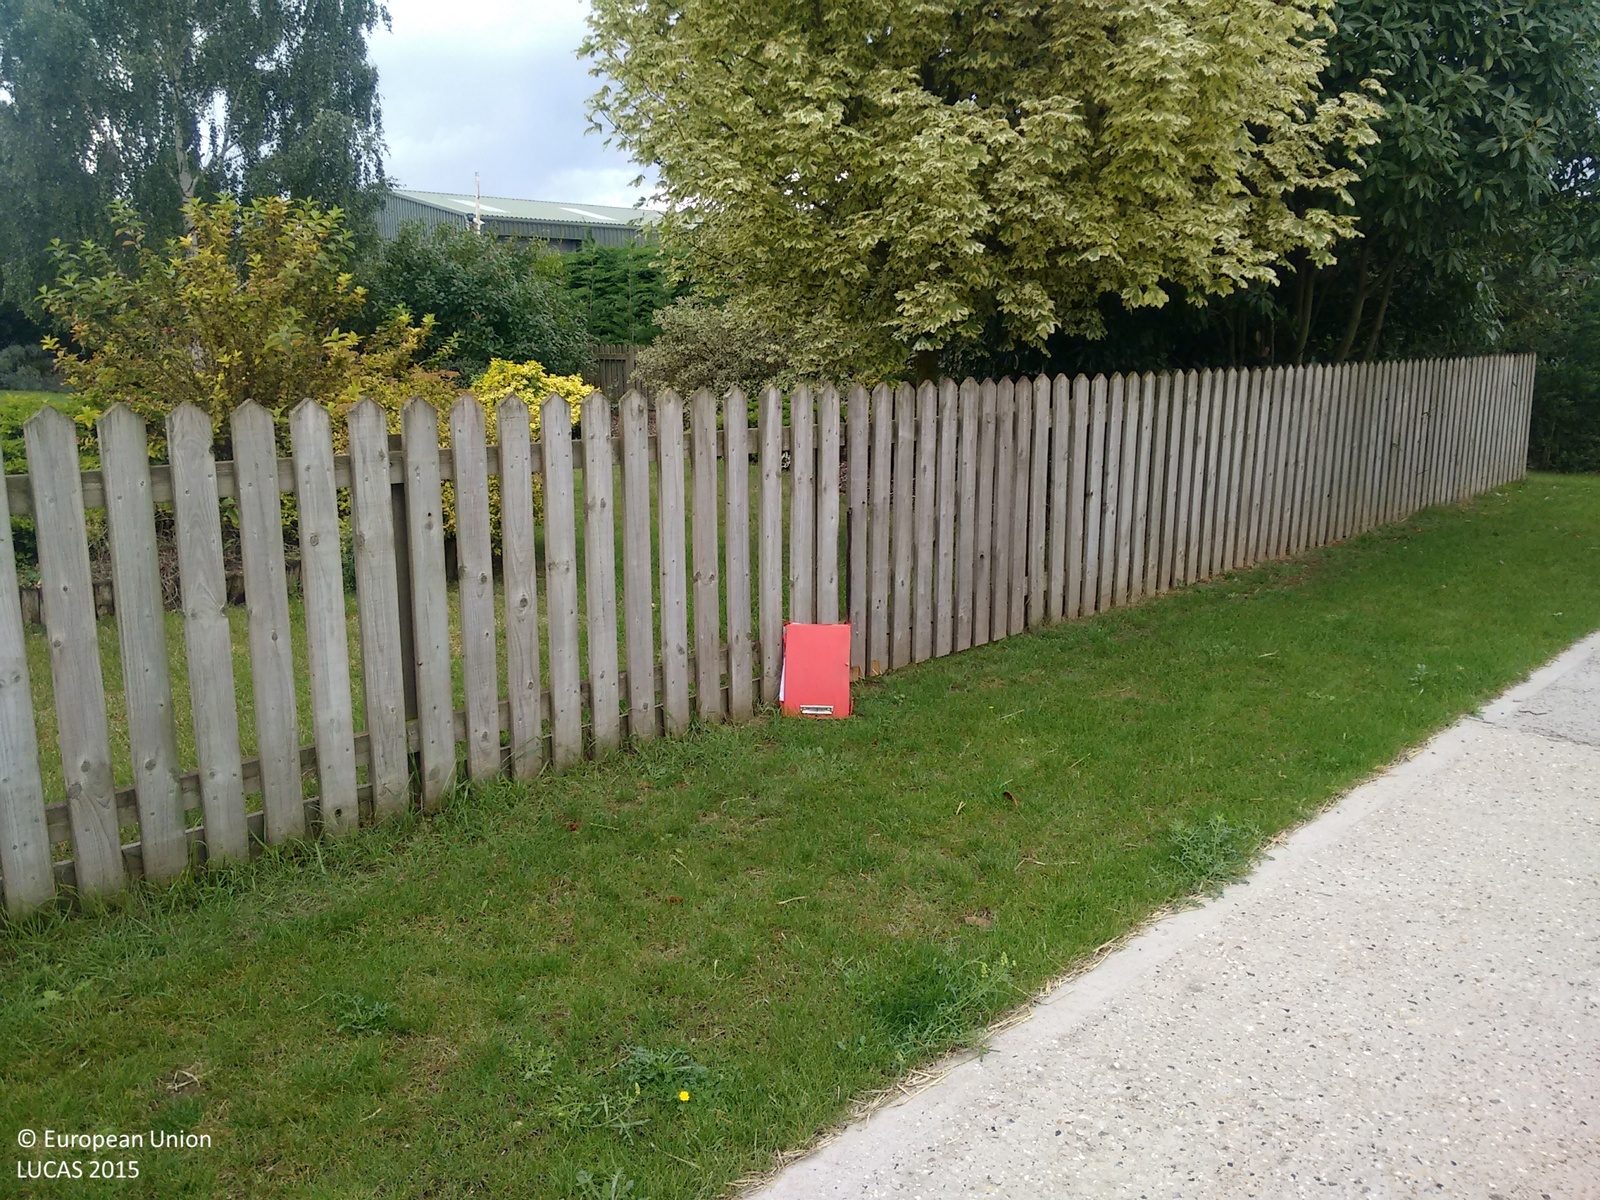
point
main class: Grassland
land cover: Grassland with sparse tree/shrub cover
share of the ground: > 75 %
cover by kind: herbaceous plants 85 %, shrubs 10 %, broadleaved forest trees 5 %
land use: Residential
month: September
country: GB
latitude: 52.3153
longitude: 0.4219
